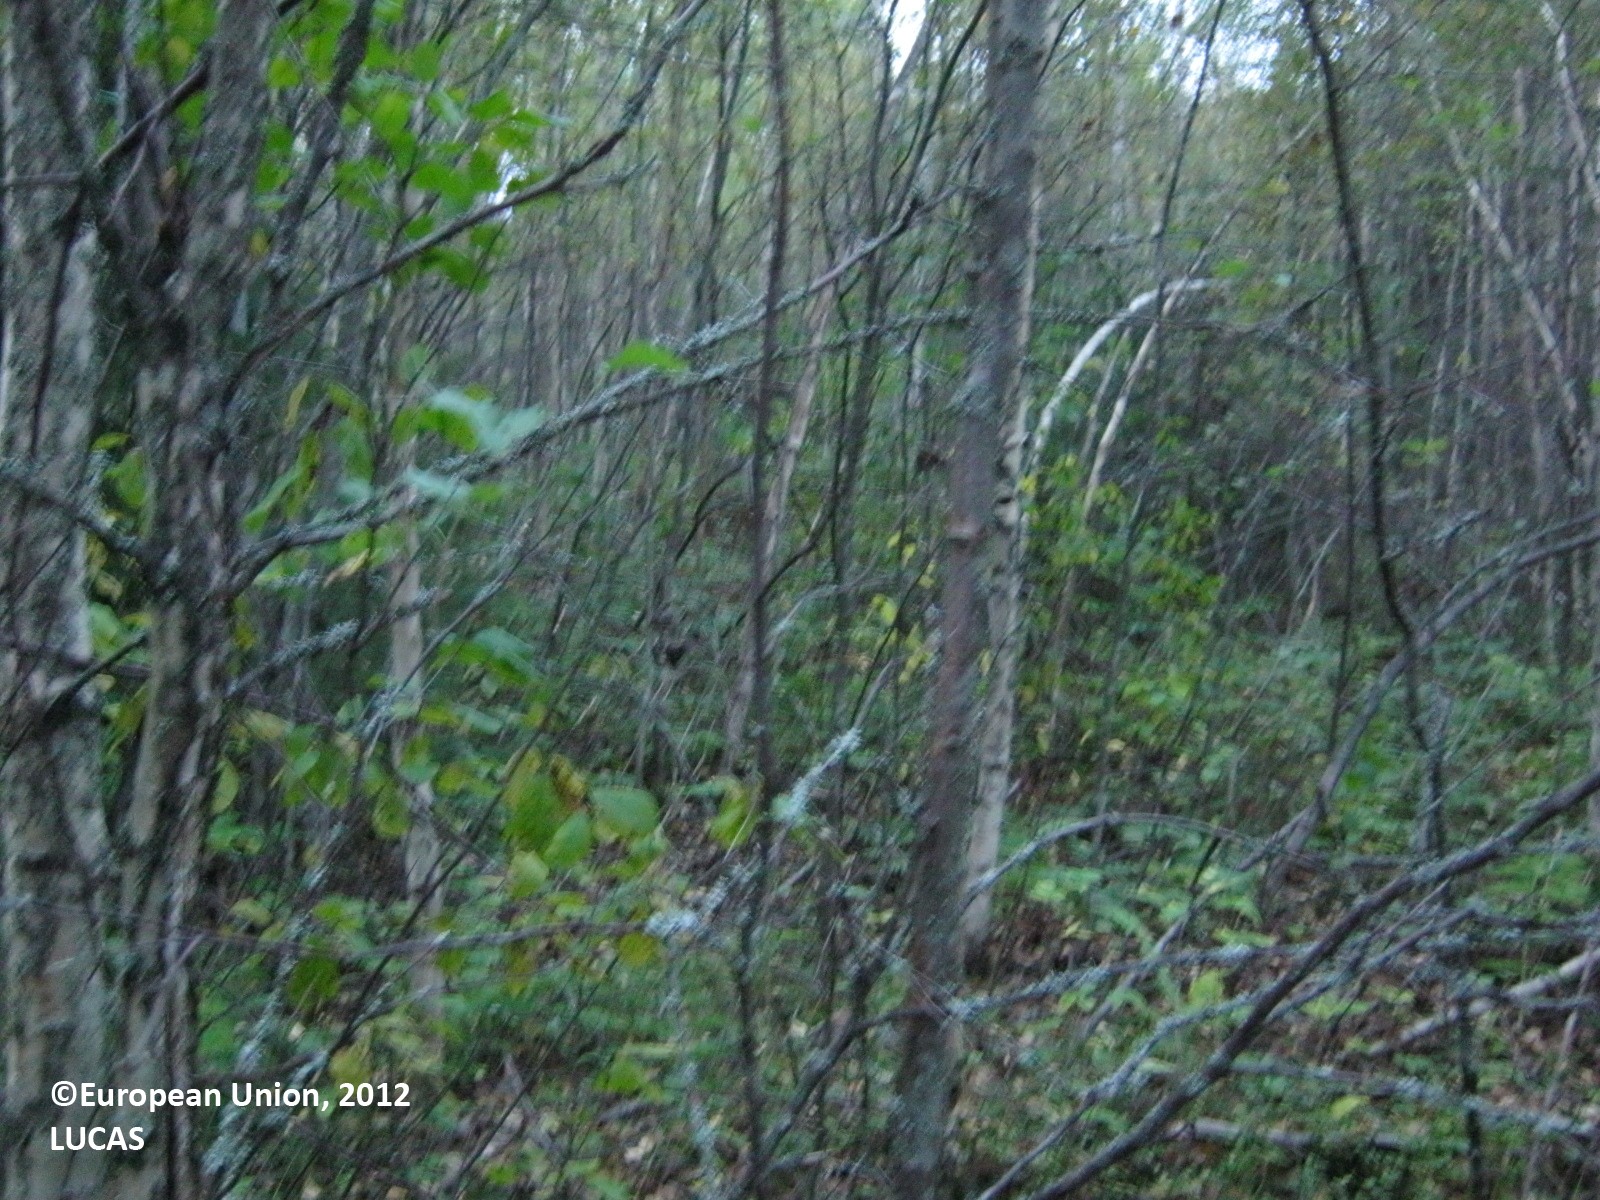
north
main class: Woodland
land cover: Broadleaved woodland
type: boreal forest
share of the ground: > 75 %
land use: Forestry
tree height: > 5 m
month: September
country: FI
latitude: 60.7275
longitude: 27.8900
